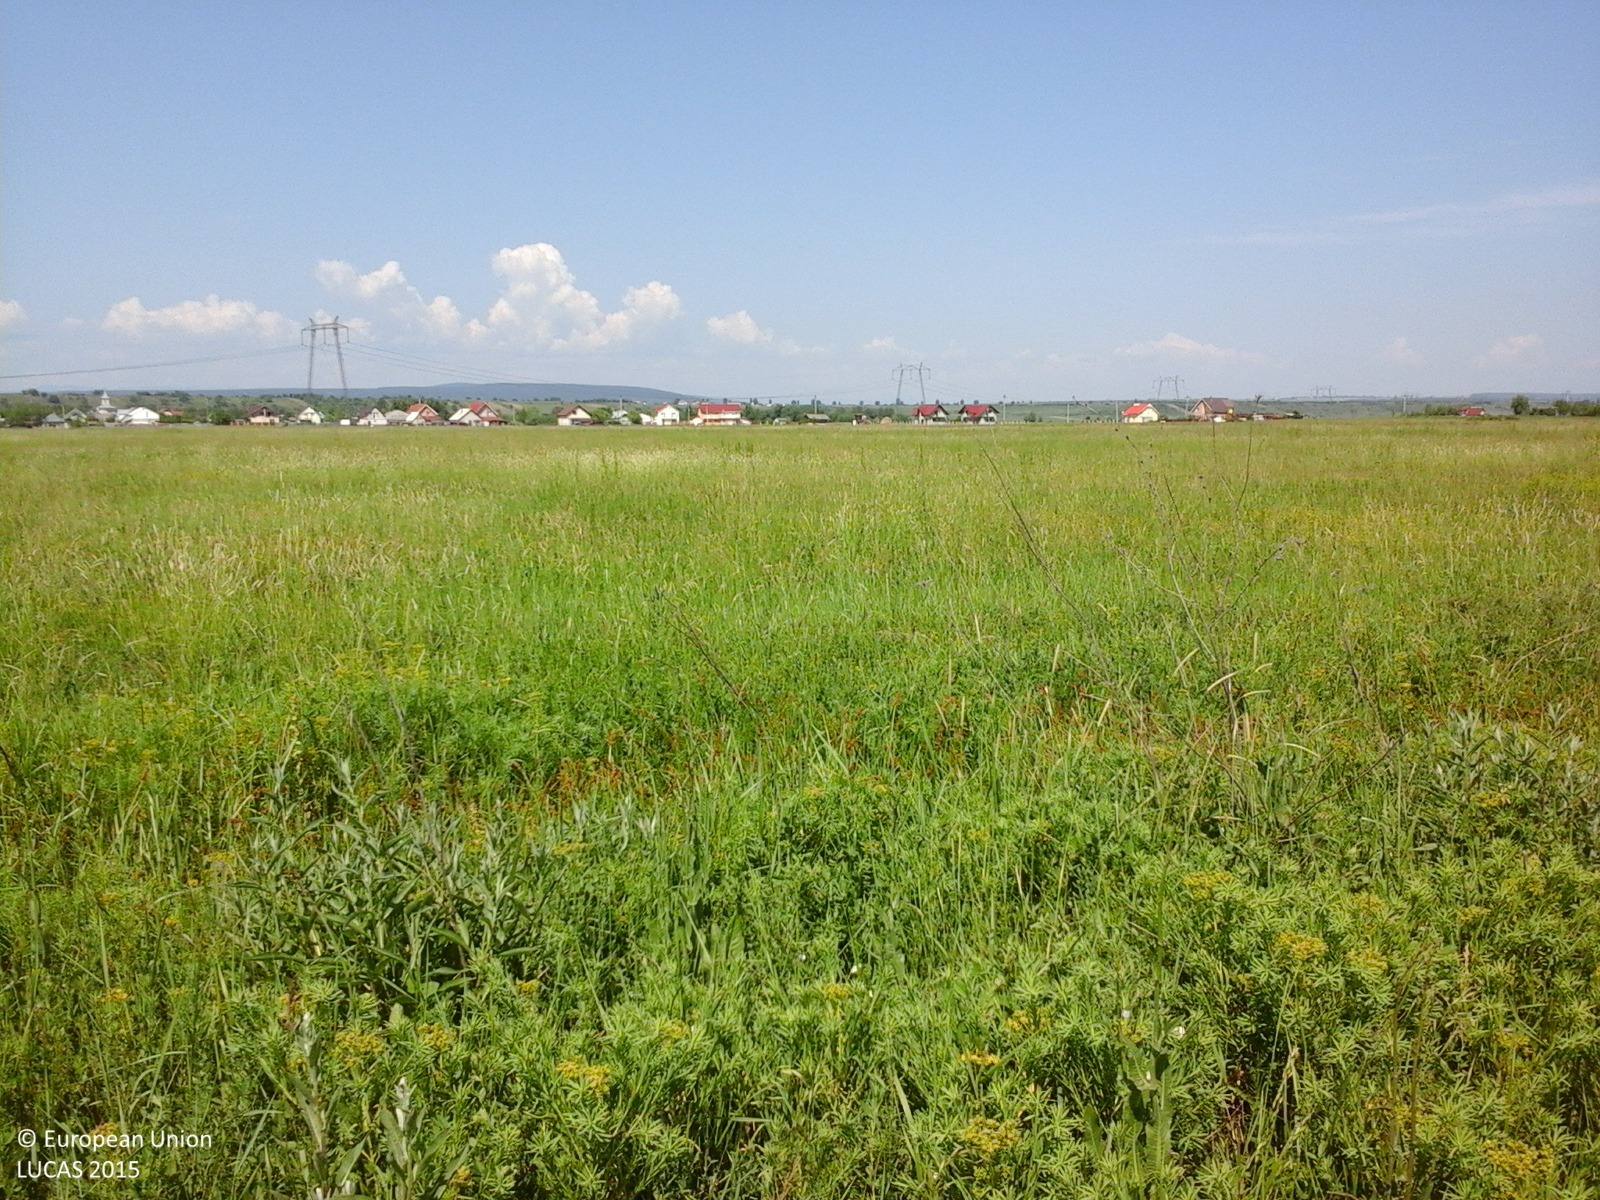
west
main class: Grassland
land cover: Grassland without tree/shrub cover
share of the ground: > 75 %
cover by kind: herbaceous plants 100 %
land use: Agriculture (excluding fallow land and kitchen gardens)
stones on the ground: < 10 %
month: June
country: RO
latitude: 46.6215
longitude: 26.9551
